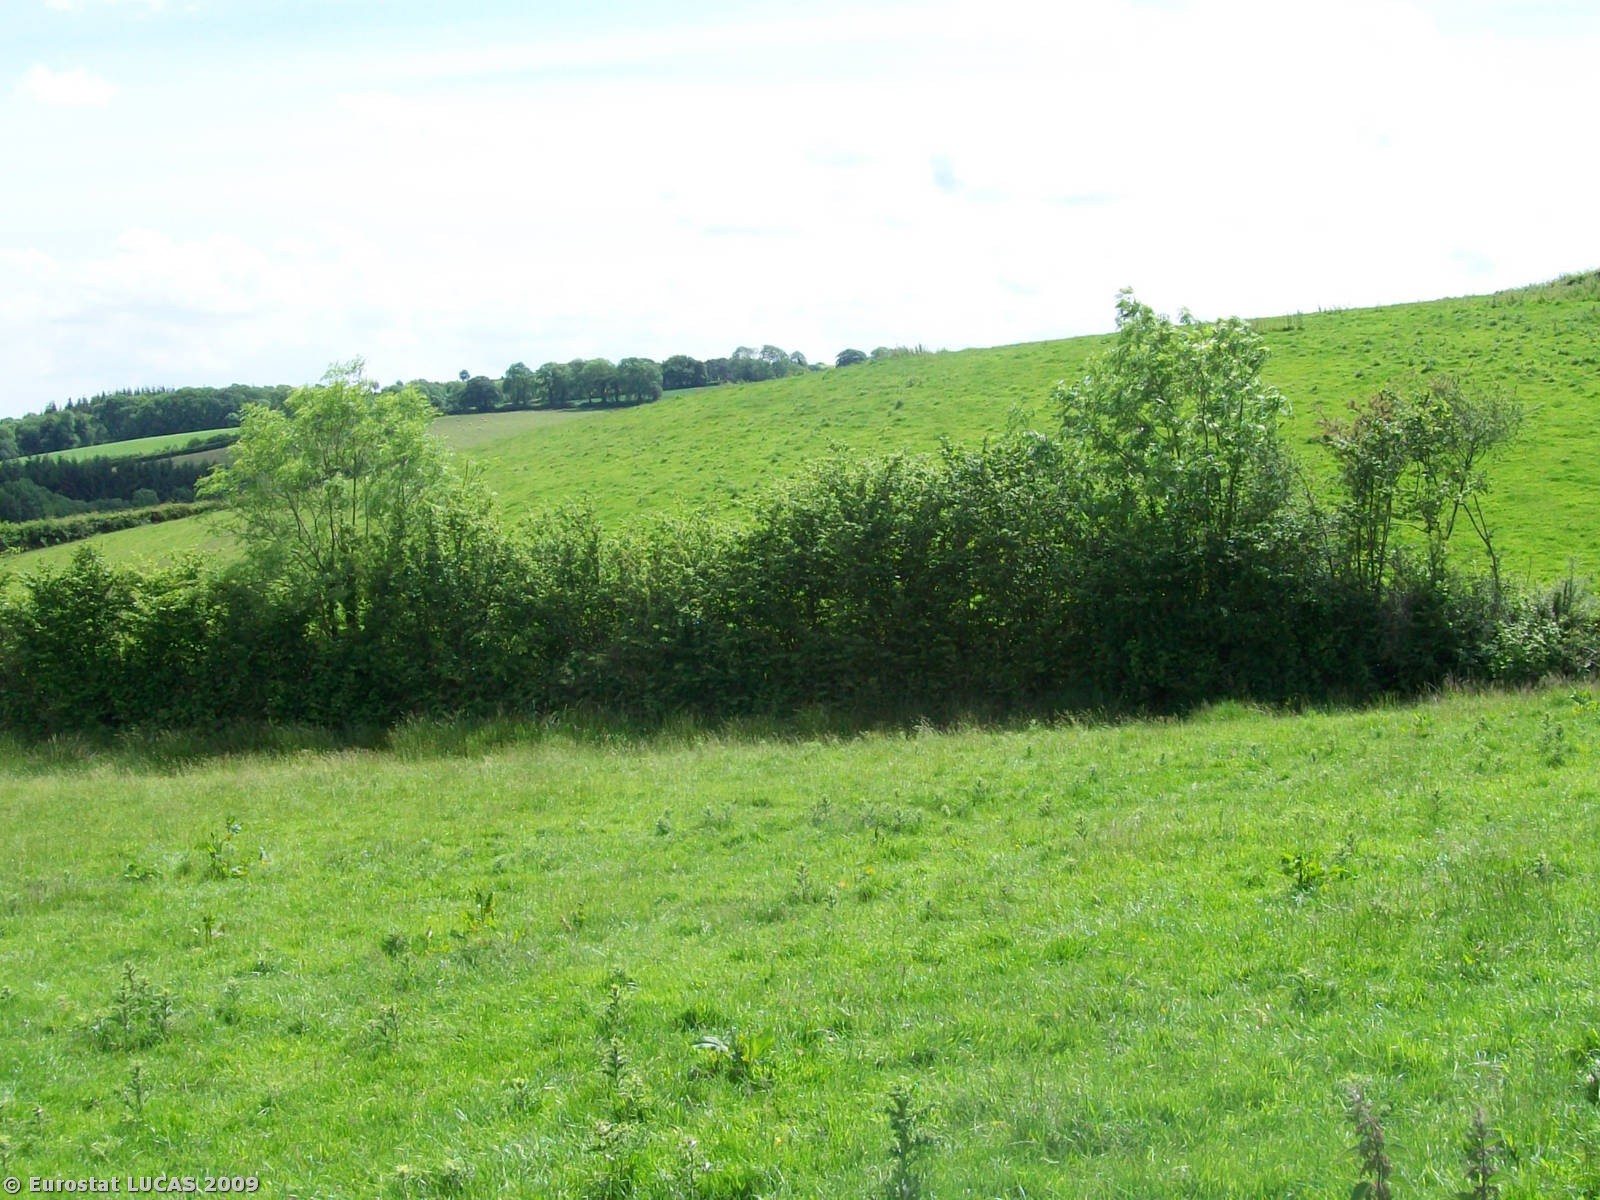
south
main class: Grassland
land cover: Grassland without tree/shrub cover
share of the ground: > 75 %
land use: Agriculture (excluding fallow land and kitchen gardens)
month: June
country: GB
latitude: 50.9510
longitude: -3.4495
